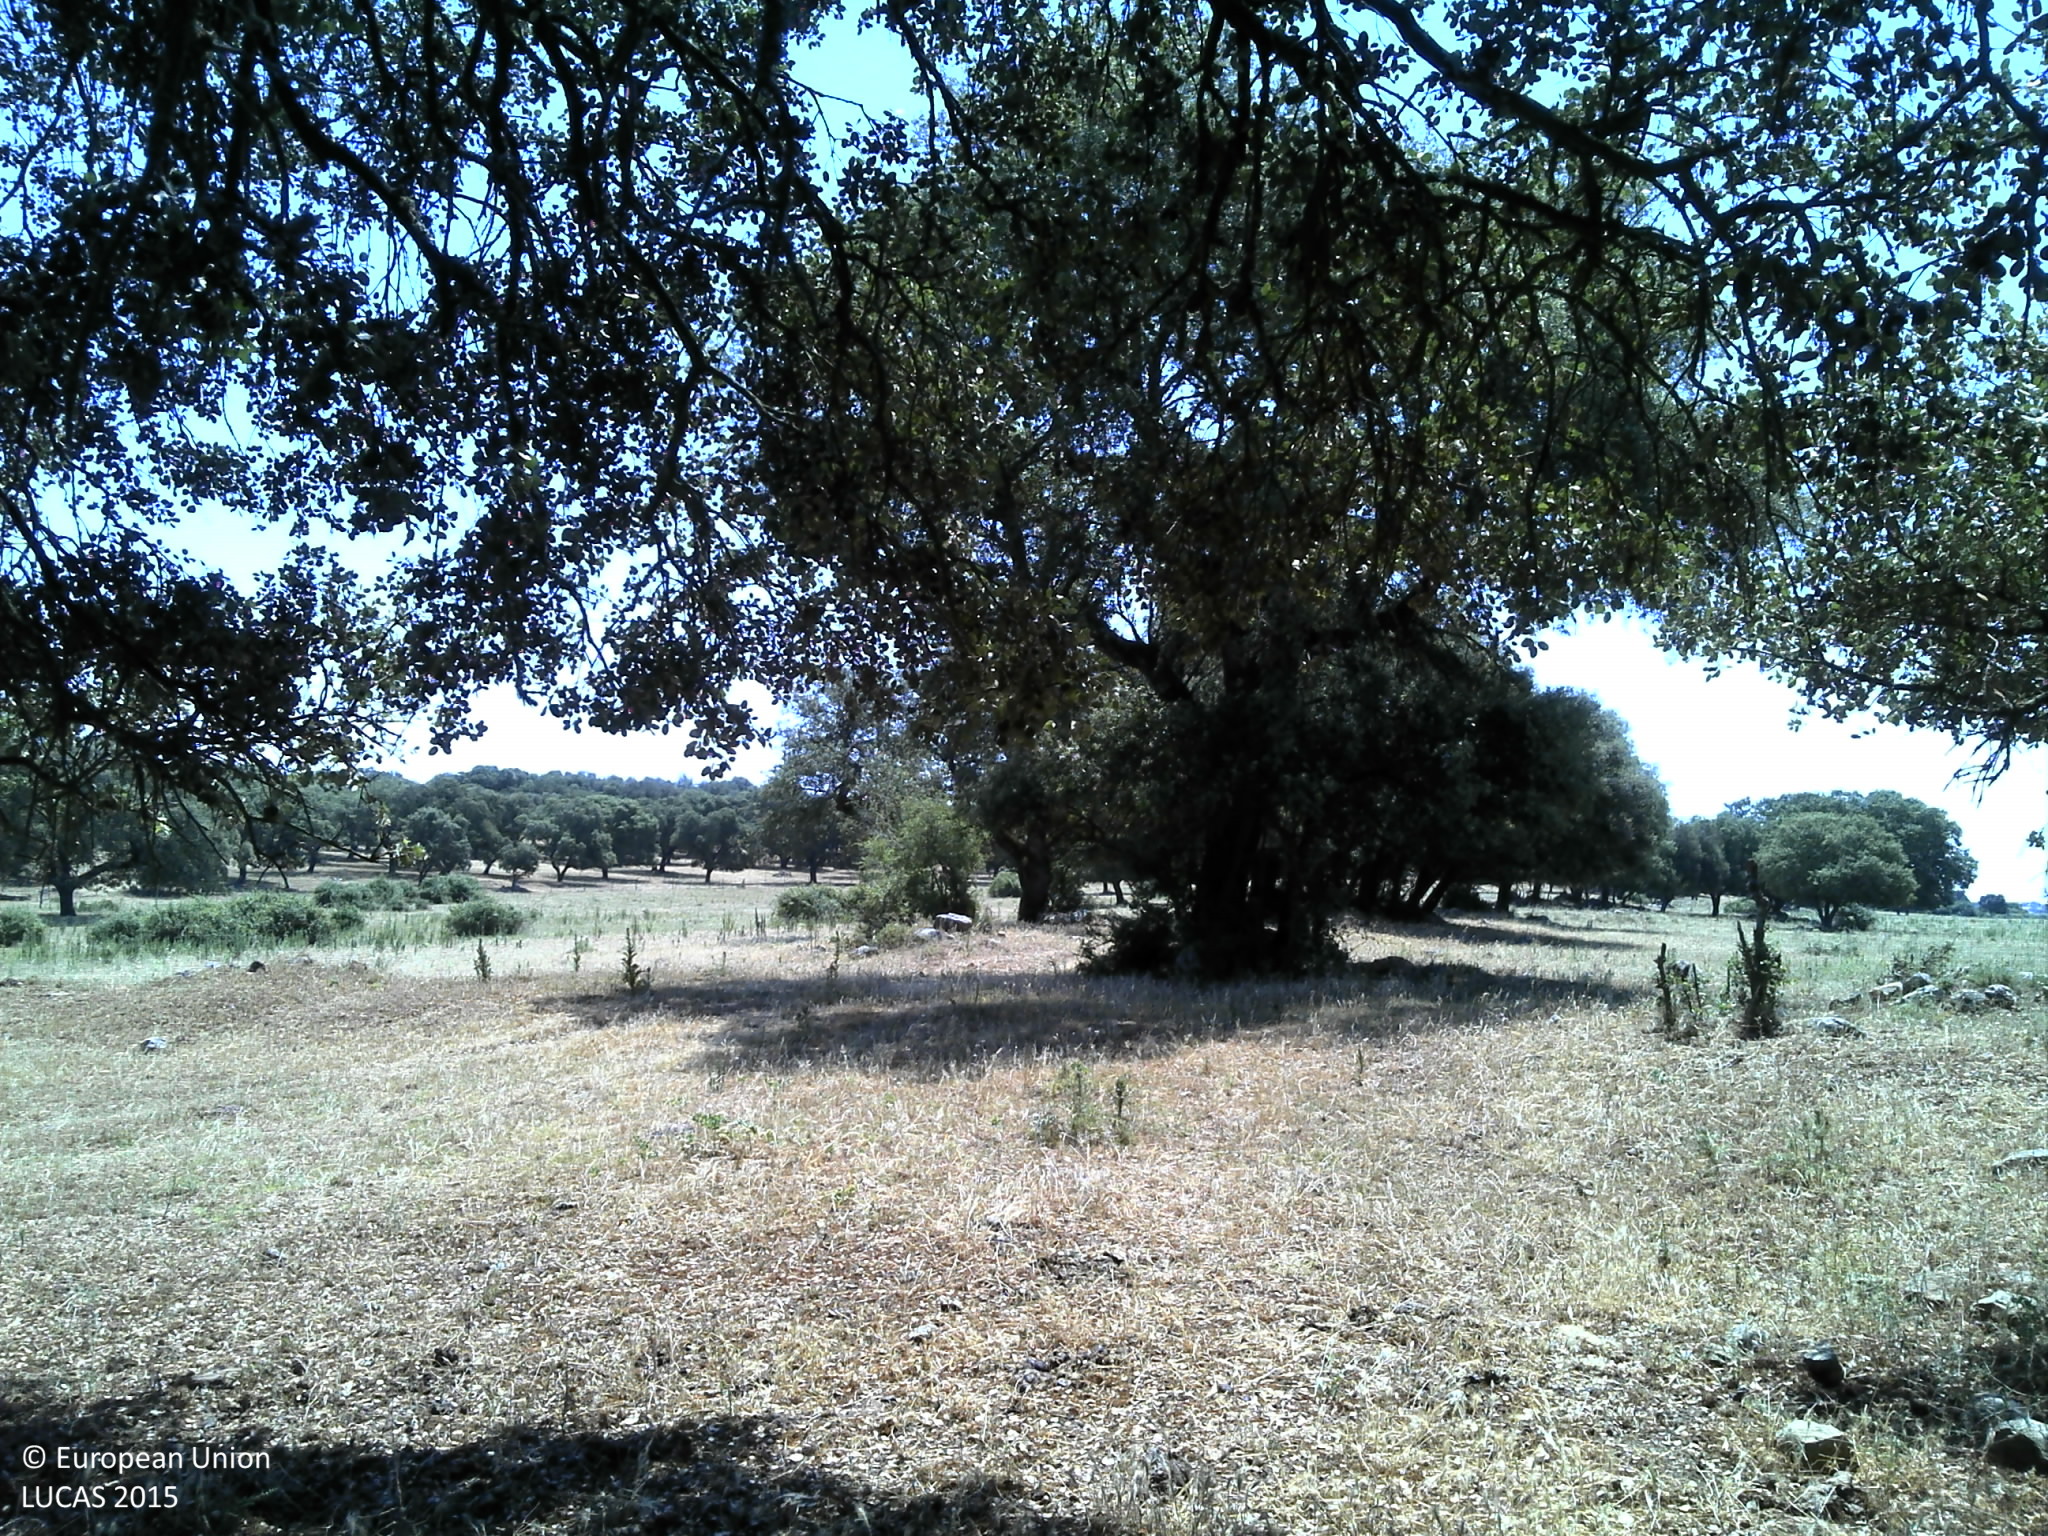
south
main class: Woodland
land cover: Broadleaved woodland
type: broadleaved evergreen forest
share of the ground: 25 - 50 %
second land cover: Grassland without tree/shrub cover
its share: 25 - 50 %
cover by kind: herbaceous plants 50 %, broadleaved forest trees 30 %, unconsolidated bare surface 20 %
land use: Forestry
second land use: Agriculture (excluding fallow land and kitchen gardens)
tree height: > 5 m
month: June
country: PT
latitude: 38.6561
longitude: -8.1222
